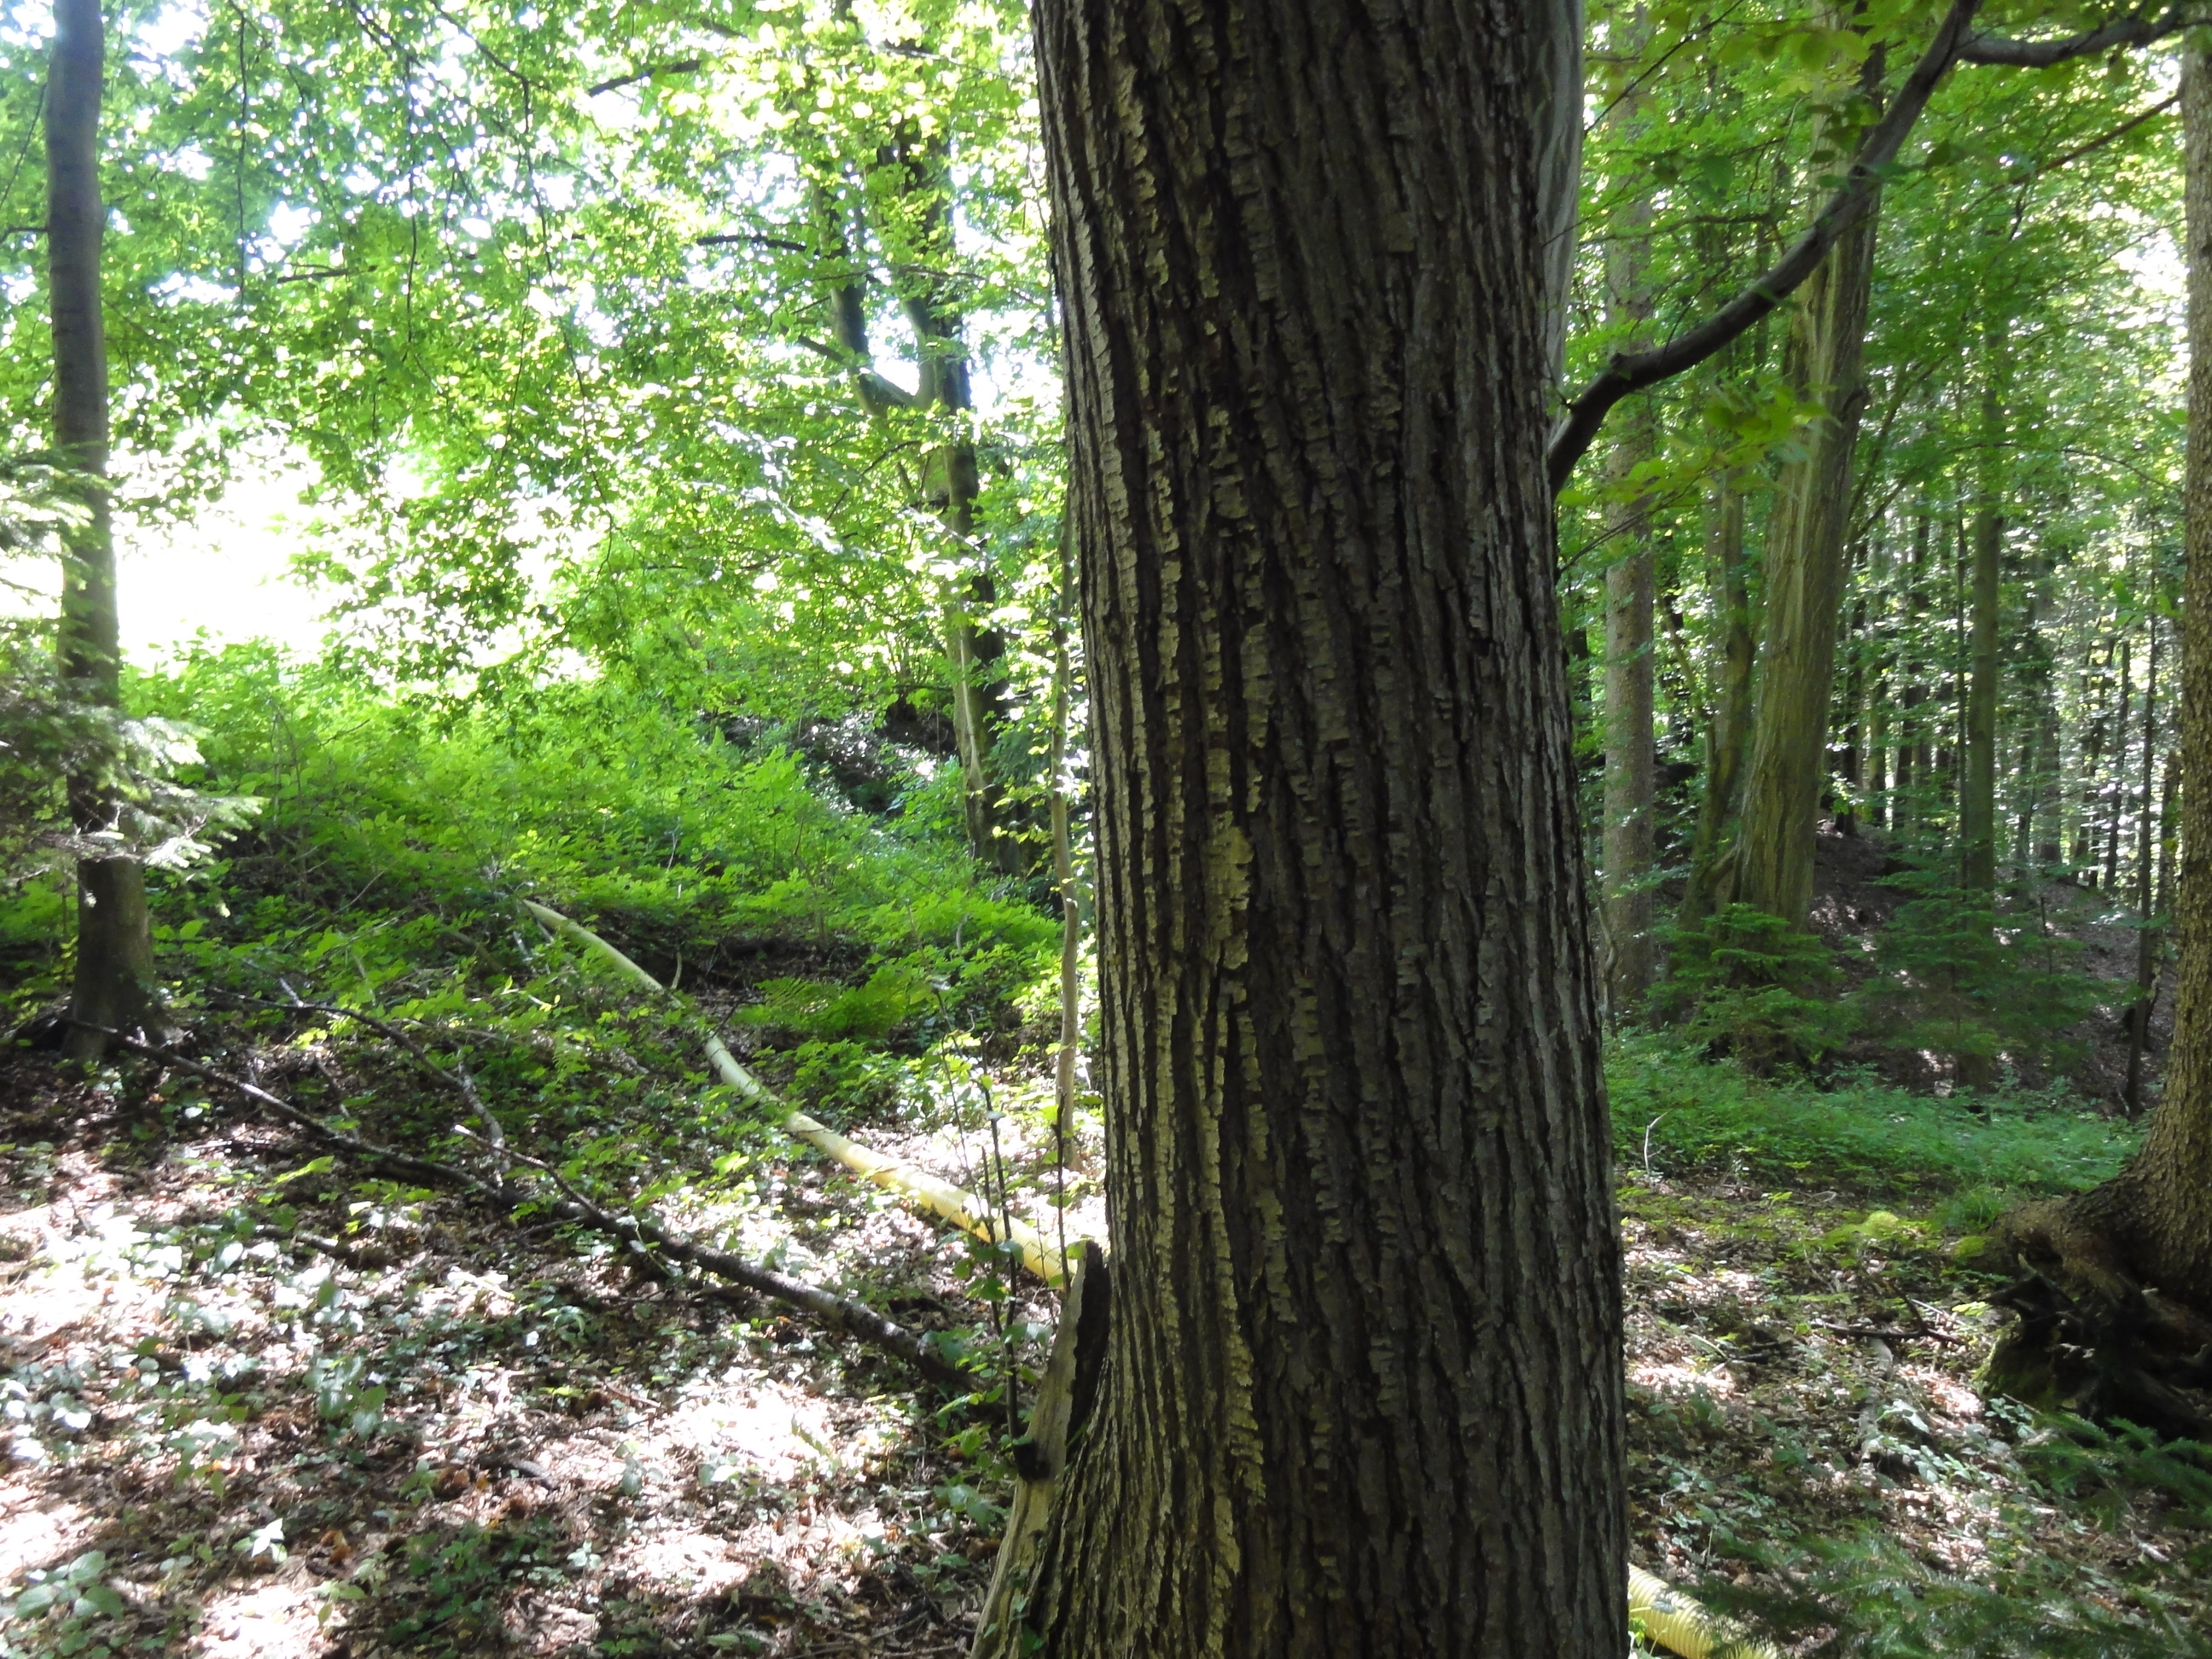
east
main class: Woodland
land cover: Spruce dominated mixed woodland
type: mountainous beech forest
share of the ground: > 75 %
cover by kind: broadleaved forest trees 65 %, coniferous forest trees 35 %
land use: Forestry
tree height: > 5 m
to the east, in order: Spruce dominated mixed woodland; Rivers and streams; Spruce dominated mixed woodland; Grassland without tree/shrub cover; Spruce dominated mixed woodland; Rivers and streams; Spruce dominated mixed woodland
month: June
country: SI
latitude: 46.1772
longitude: 15.0622
